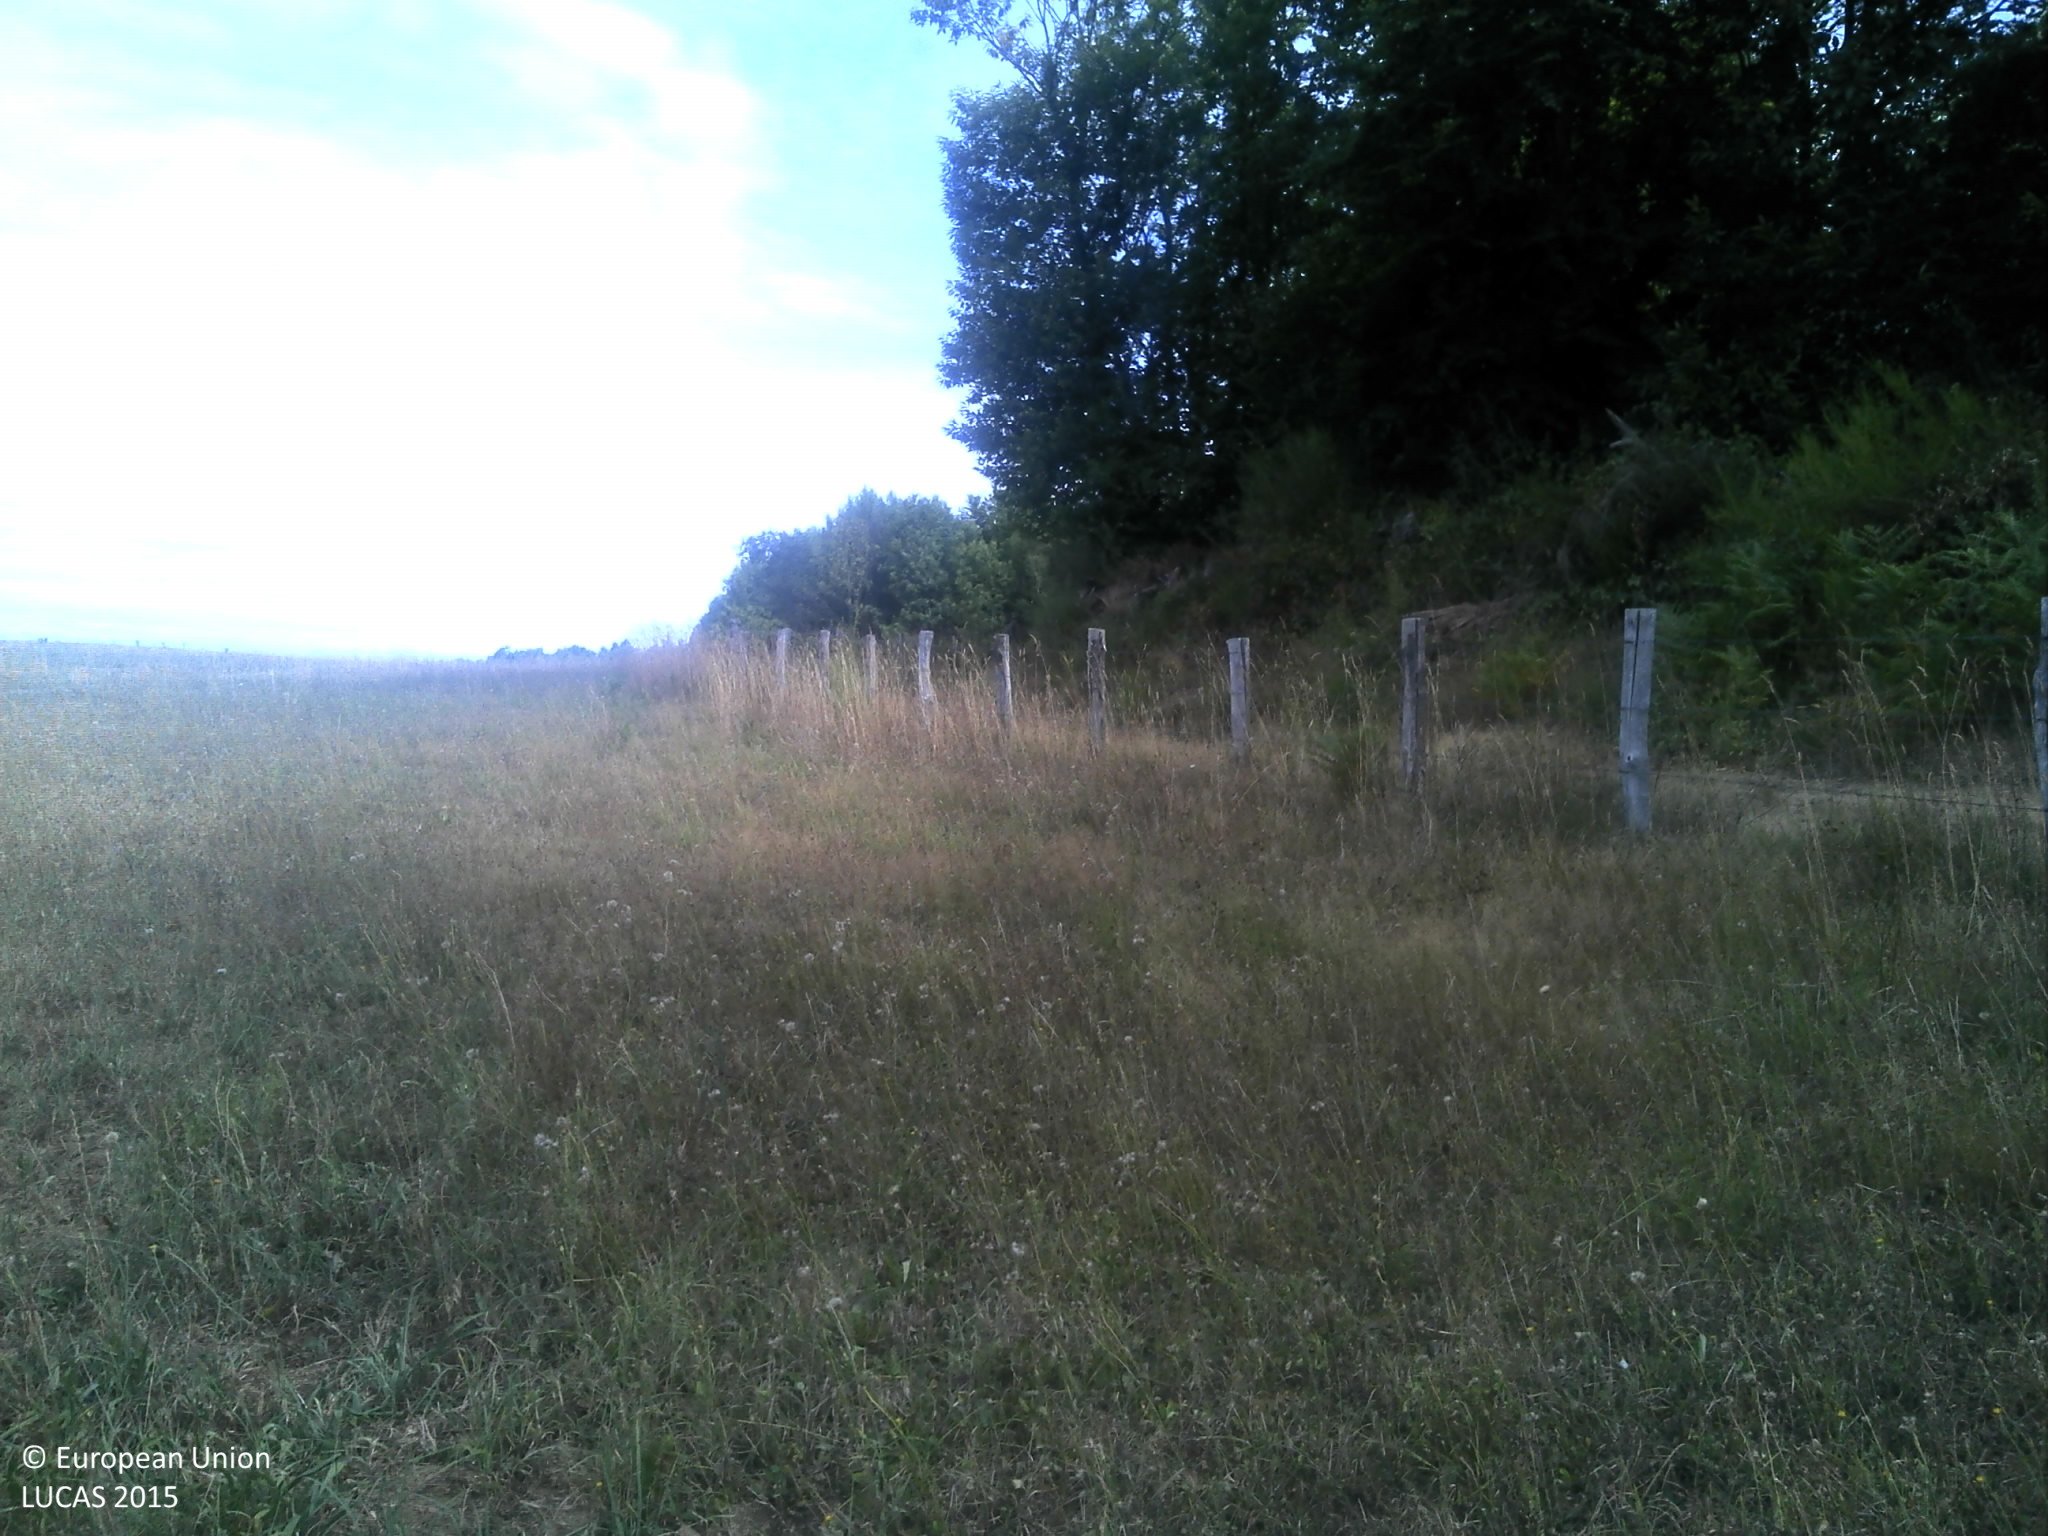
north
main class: Grassland
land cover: Grassland without tree/shrub cover
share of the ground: > 75 %
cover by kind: herbaceous plants 100 %
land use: Agriculture (excluding fallow land and kitchen gardens)
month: July
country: FR
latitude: 45.1841
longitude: 1.7878
